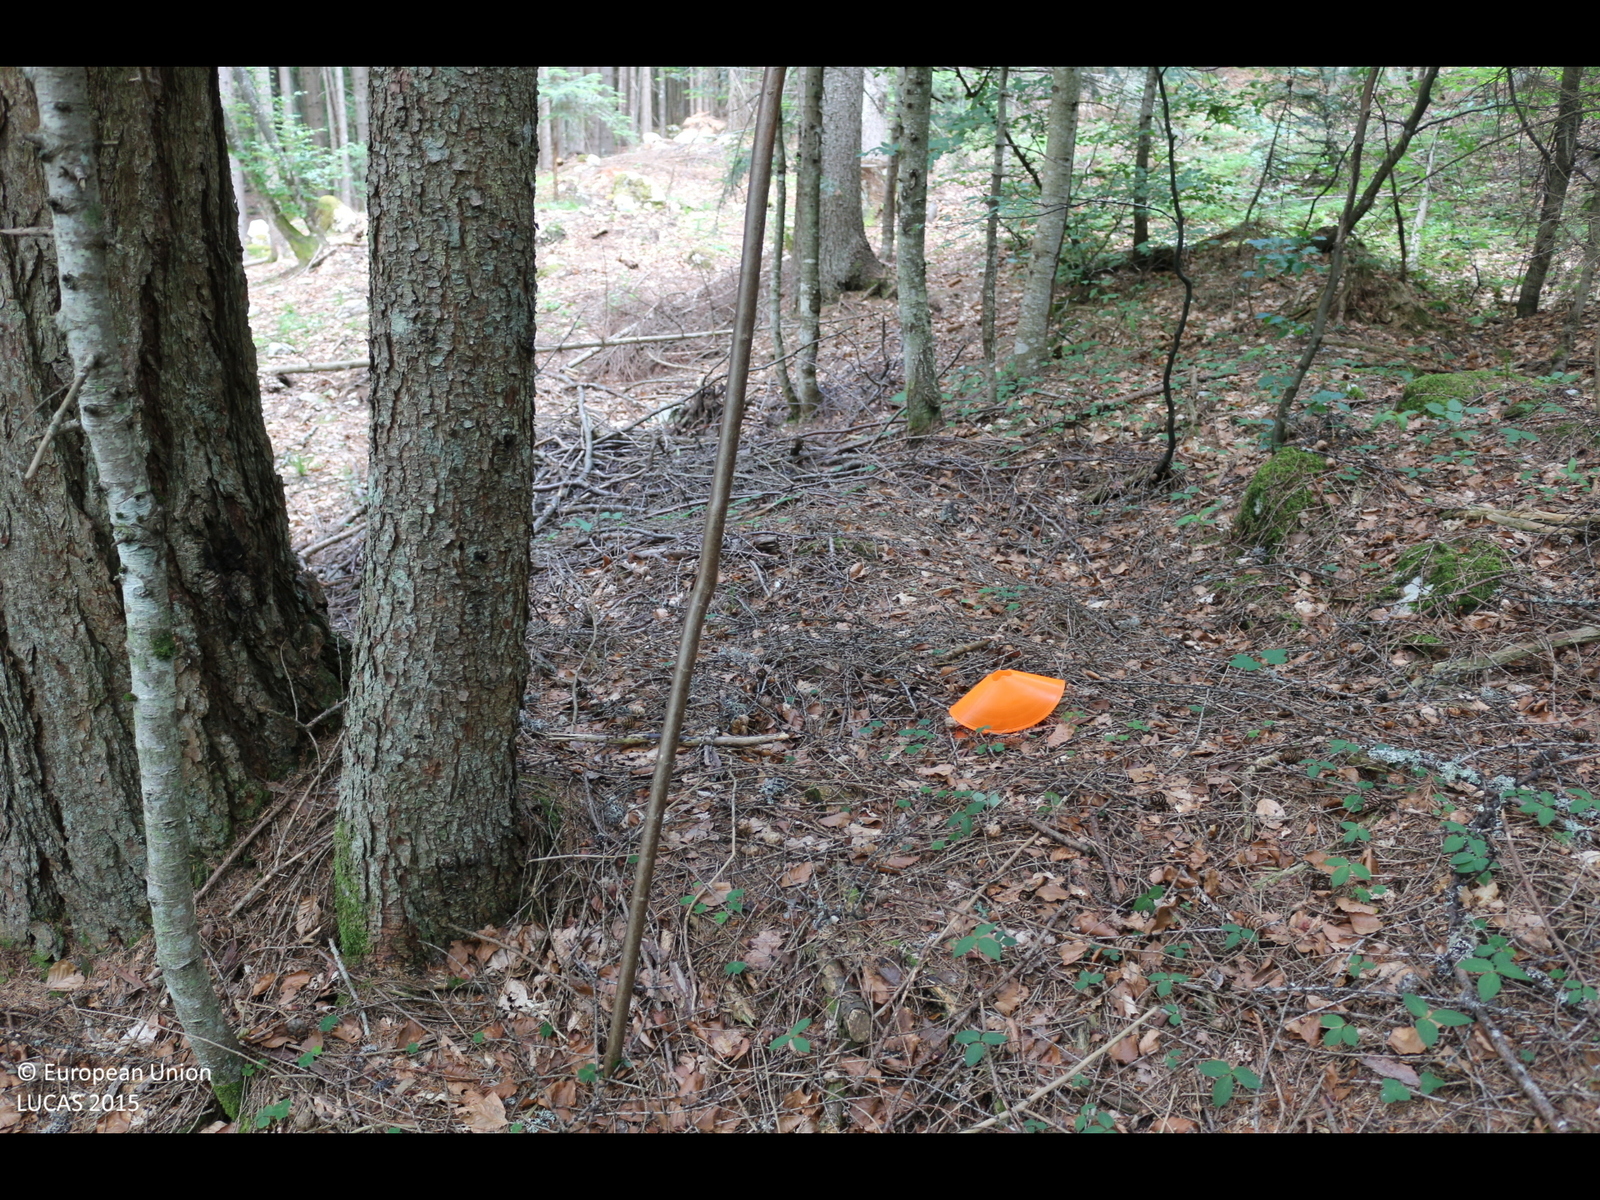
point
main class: Woodland
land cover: Spruce dominated mixed woodland
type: mountainous beech forest
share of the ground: > 75 %
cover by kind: broadleaved forest trees 60 %, coniferous forest trees 40 %
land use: Forestry
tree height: > 5 m
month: June
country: AT
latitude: 46.5308
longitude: 13.9475
